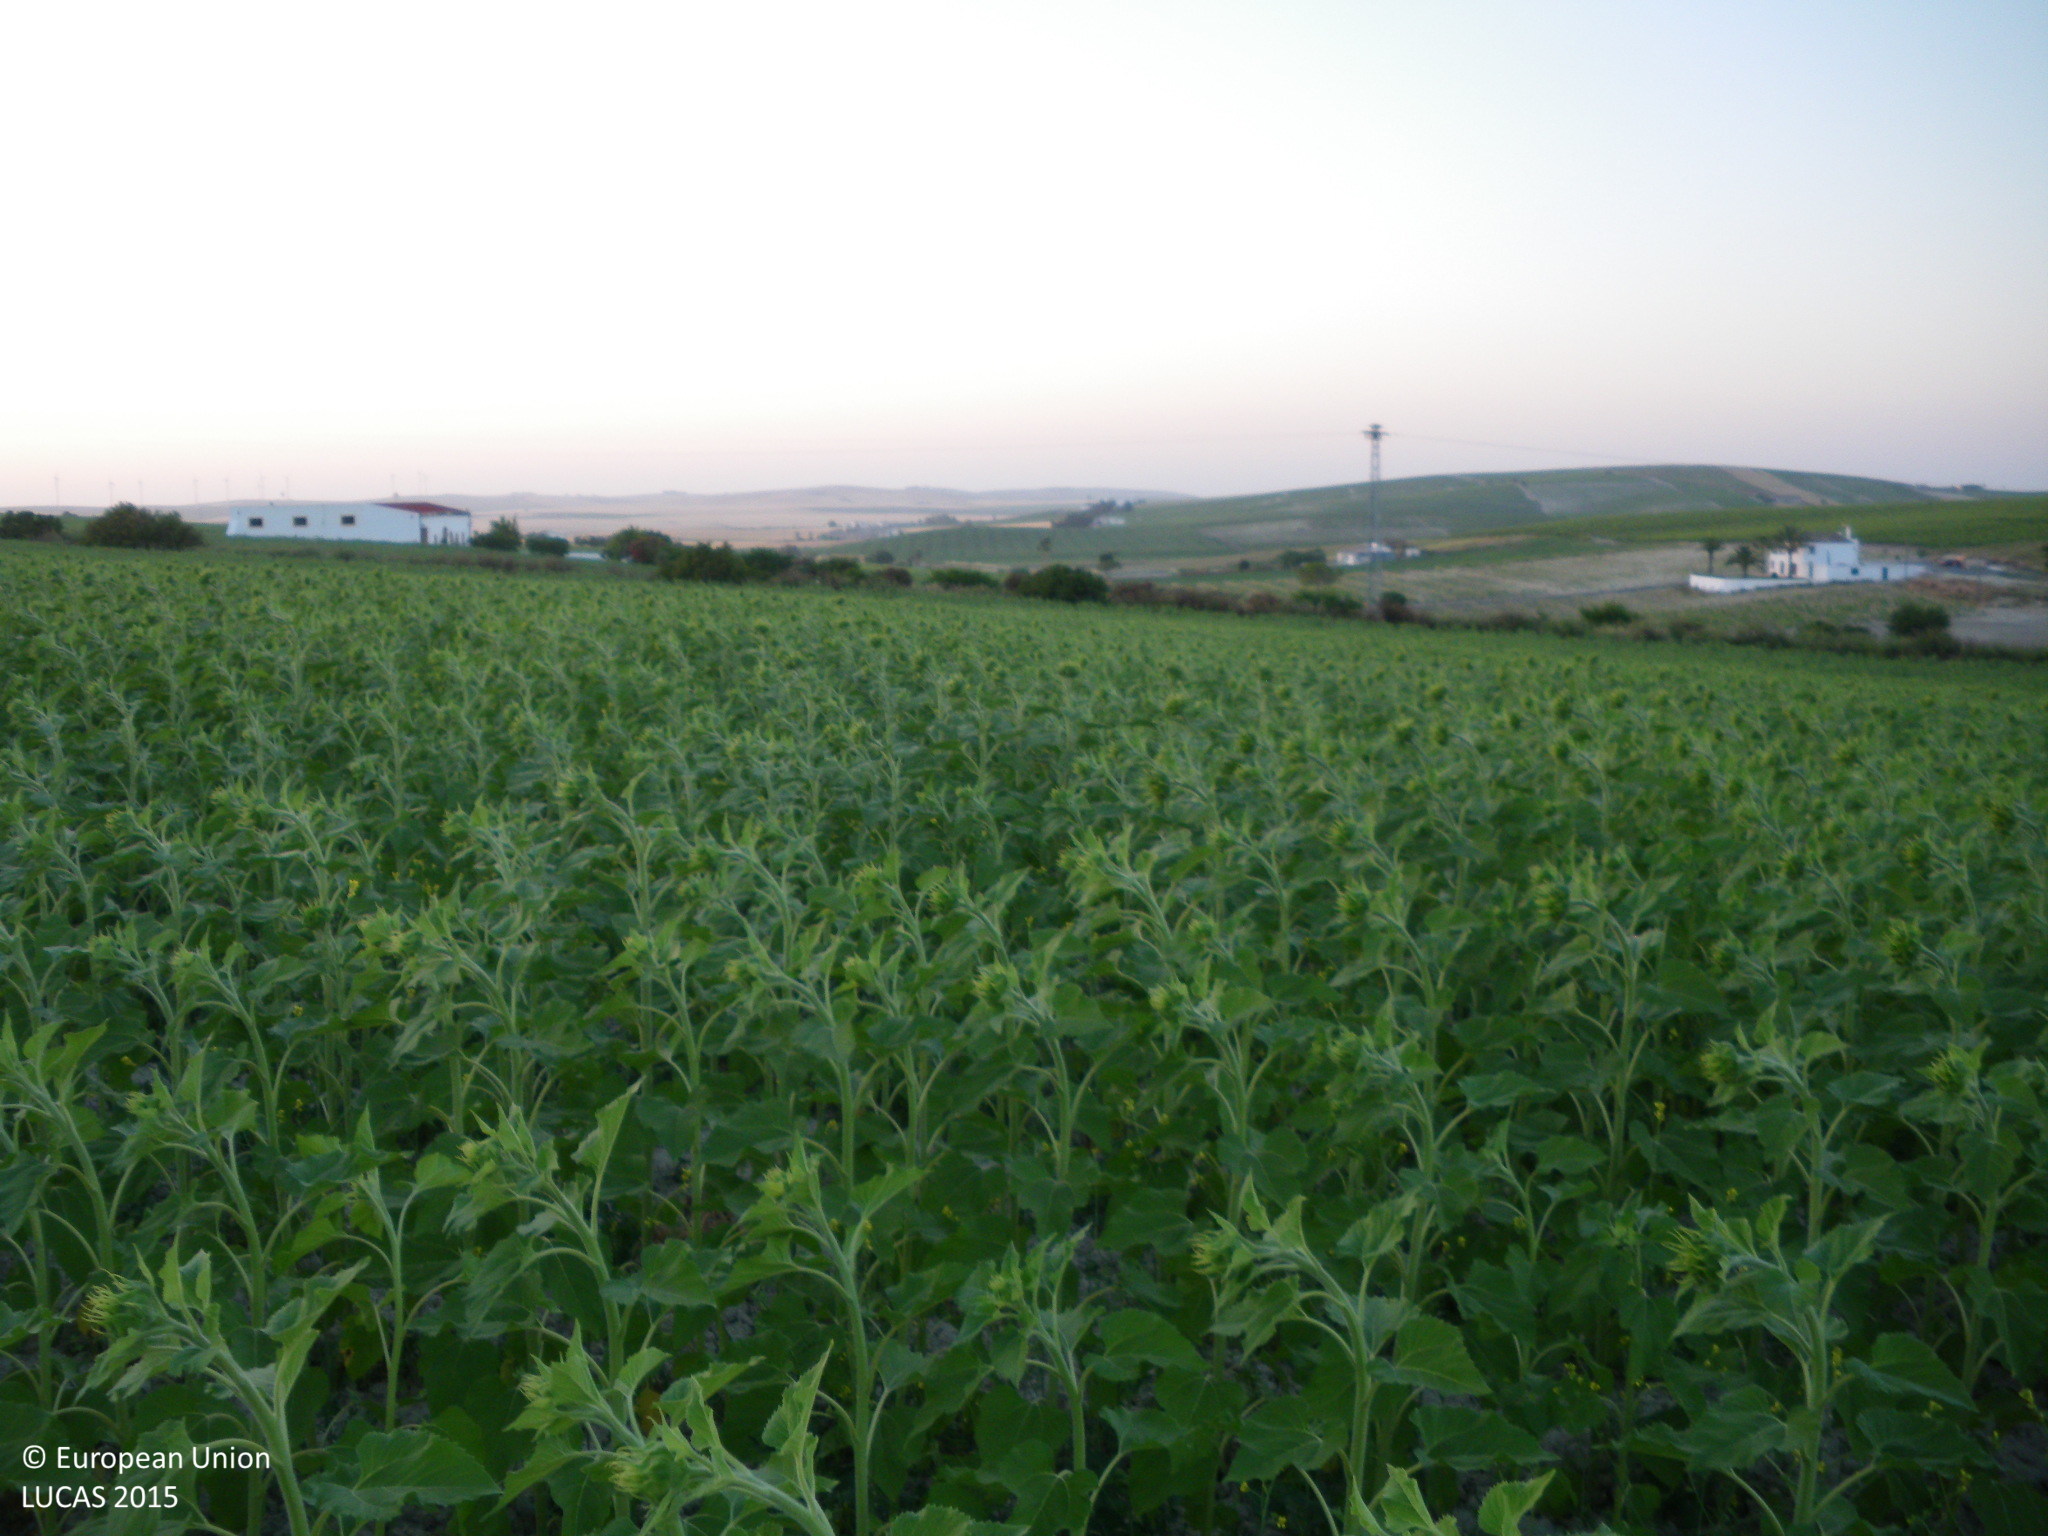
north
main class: Cropland
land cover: Sunflower
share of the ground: 50 - 75 %
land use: Agriculture (excluding fallow land and kitchen gardens)
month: May
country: ES
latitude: 36.7151
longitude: -6.2138
